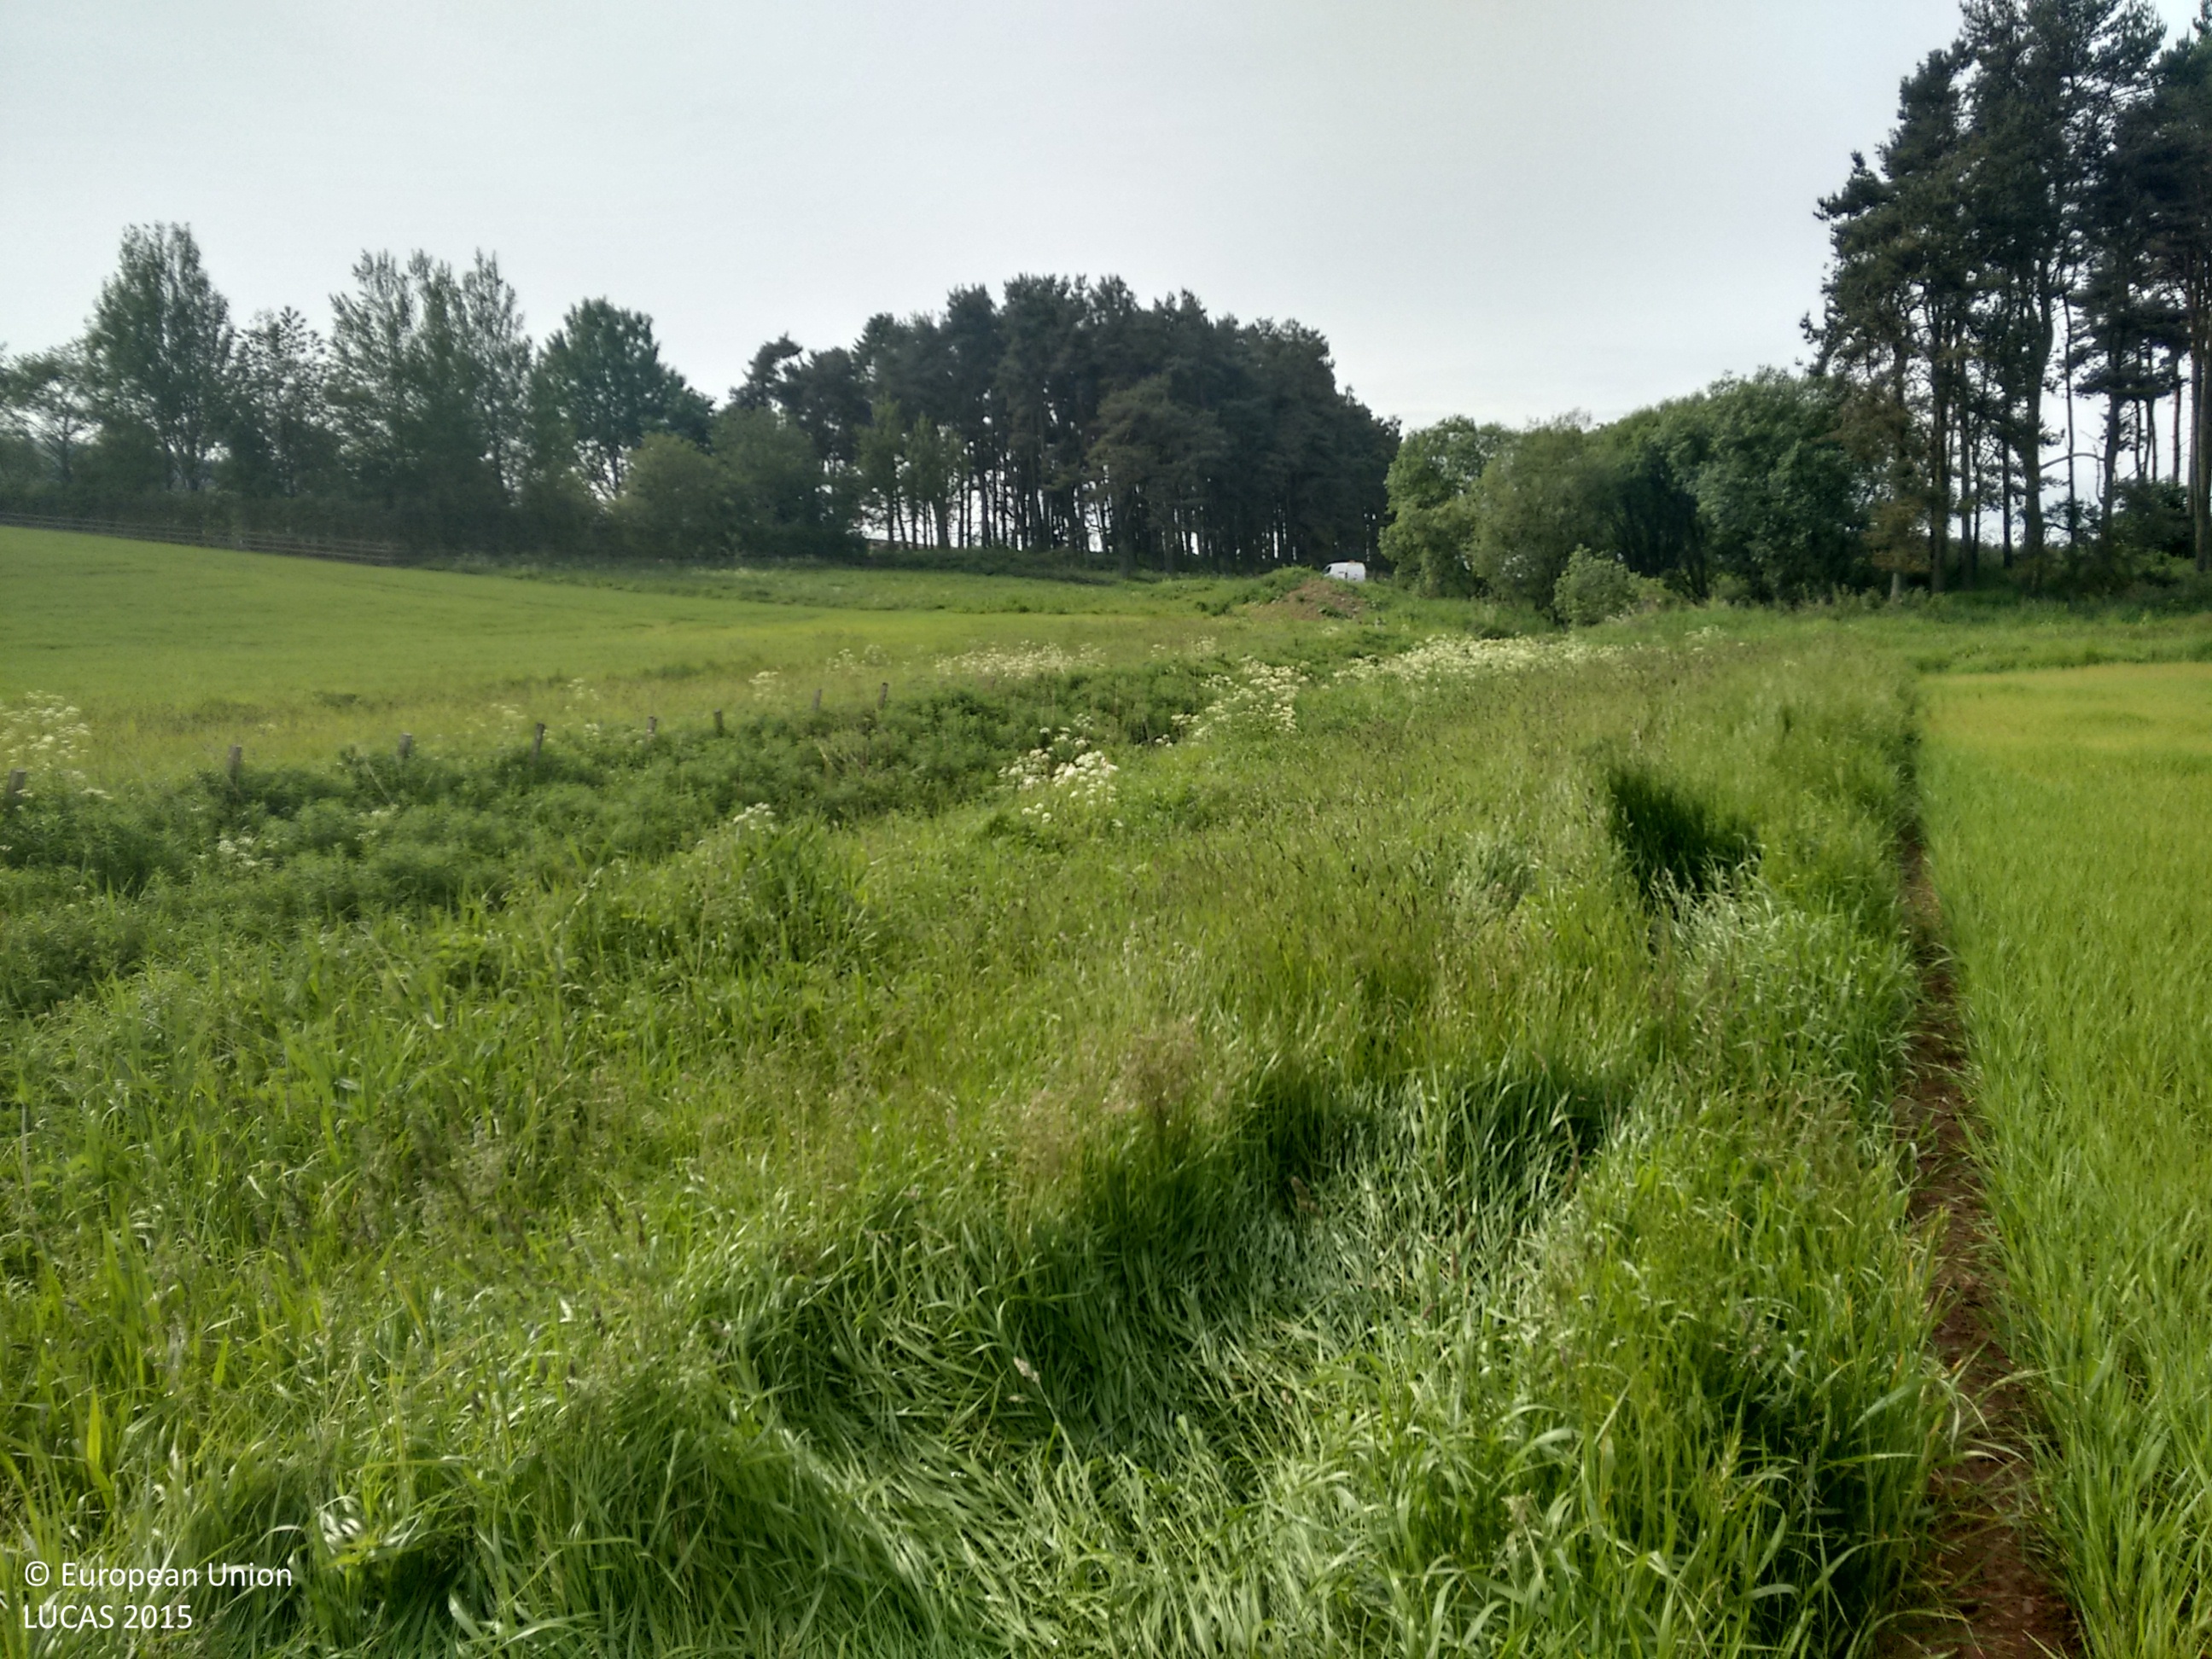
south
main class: Cropland
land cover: Barley
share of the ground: > 75 %
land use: Agriculture (excluding fallow land and kitchen gardens)
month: June
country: GB
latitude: 56.2520
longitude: -3.3566
